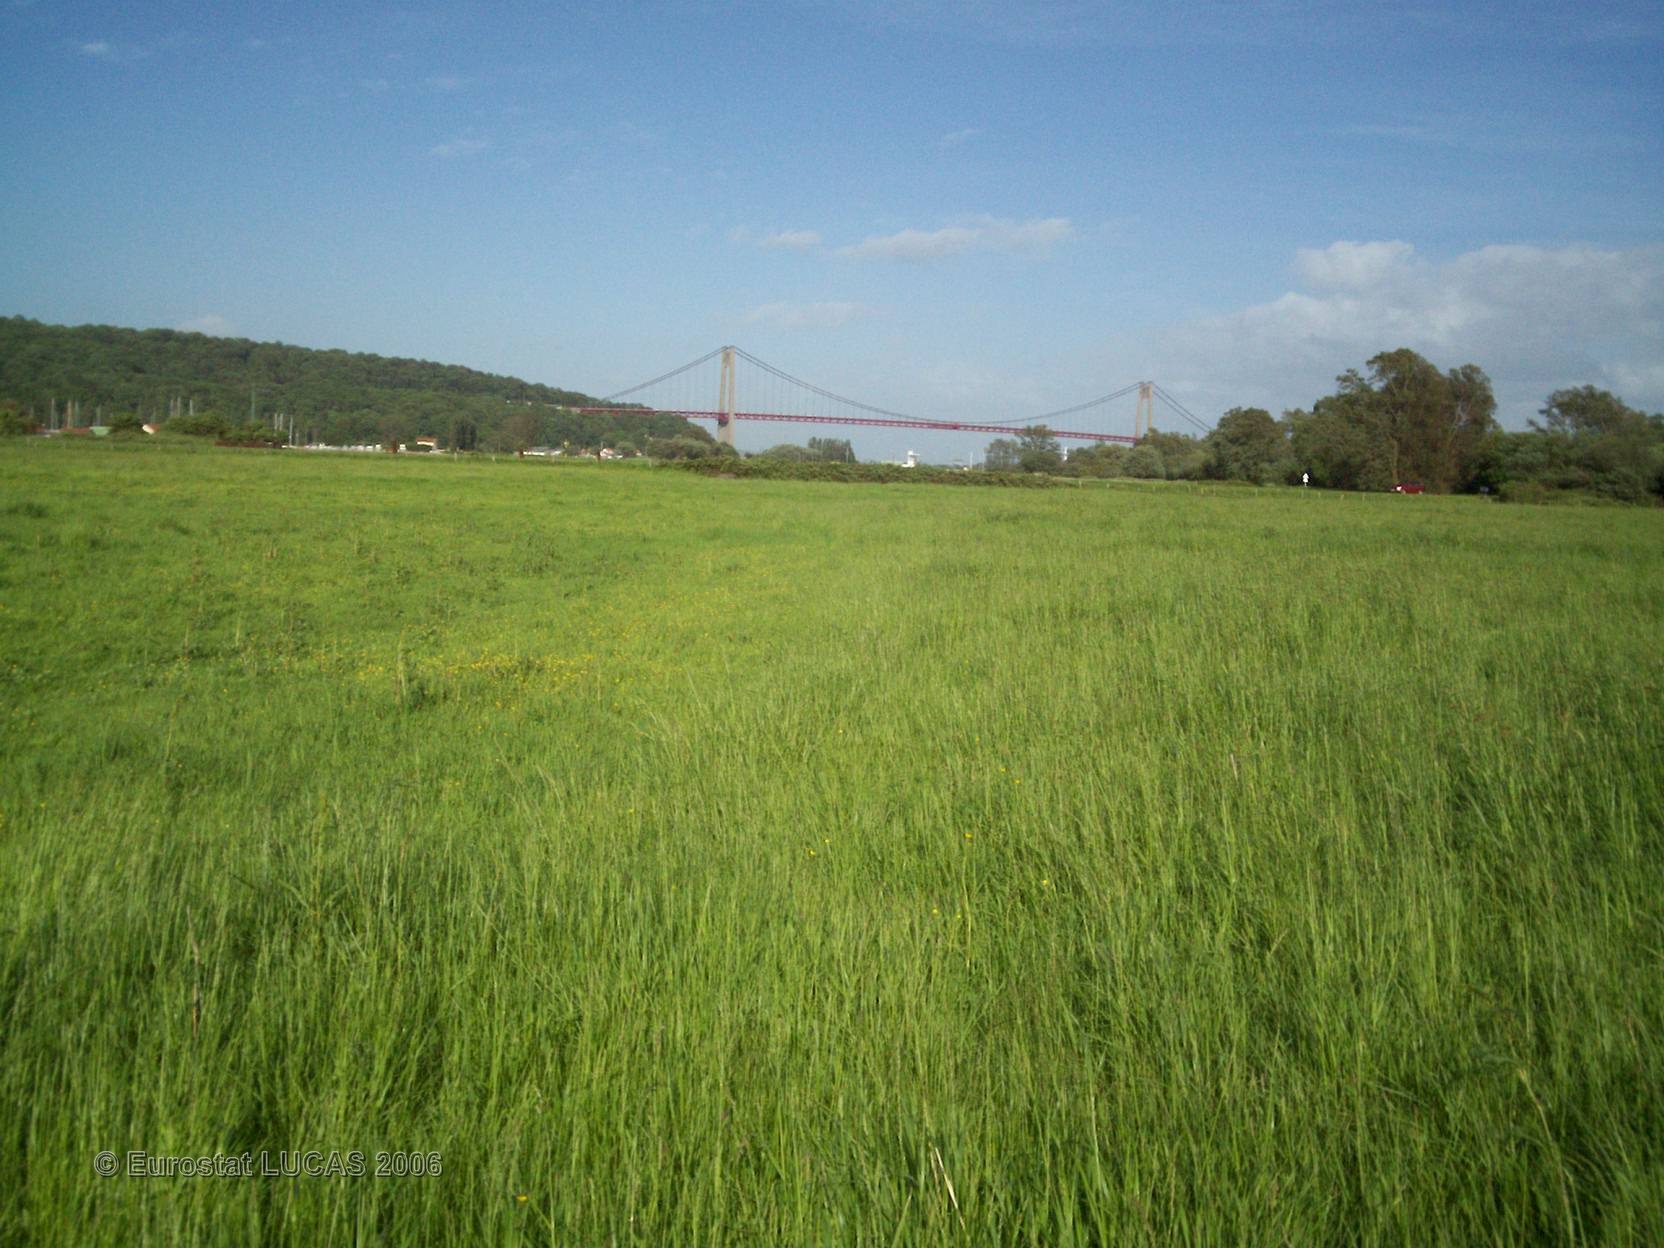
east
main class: Grassland
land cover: Grassland without tree/shrub cover
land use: Agriculture (excluding fallow land and kitchen gardens)
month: May
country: FR
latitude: 49.4735
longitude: 0.4366
